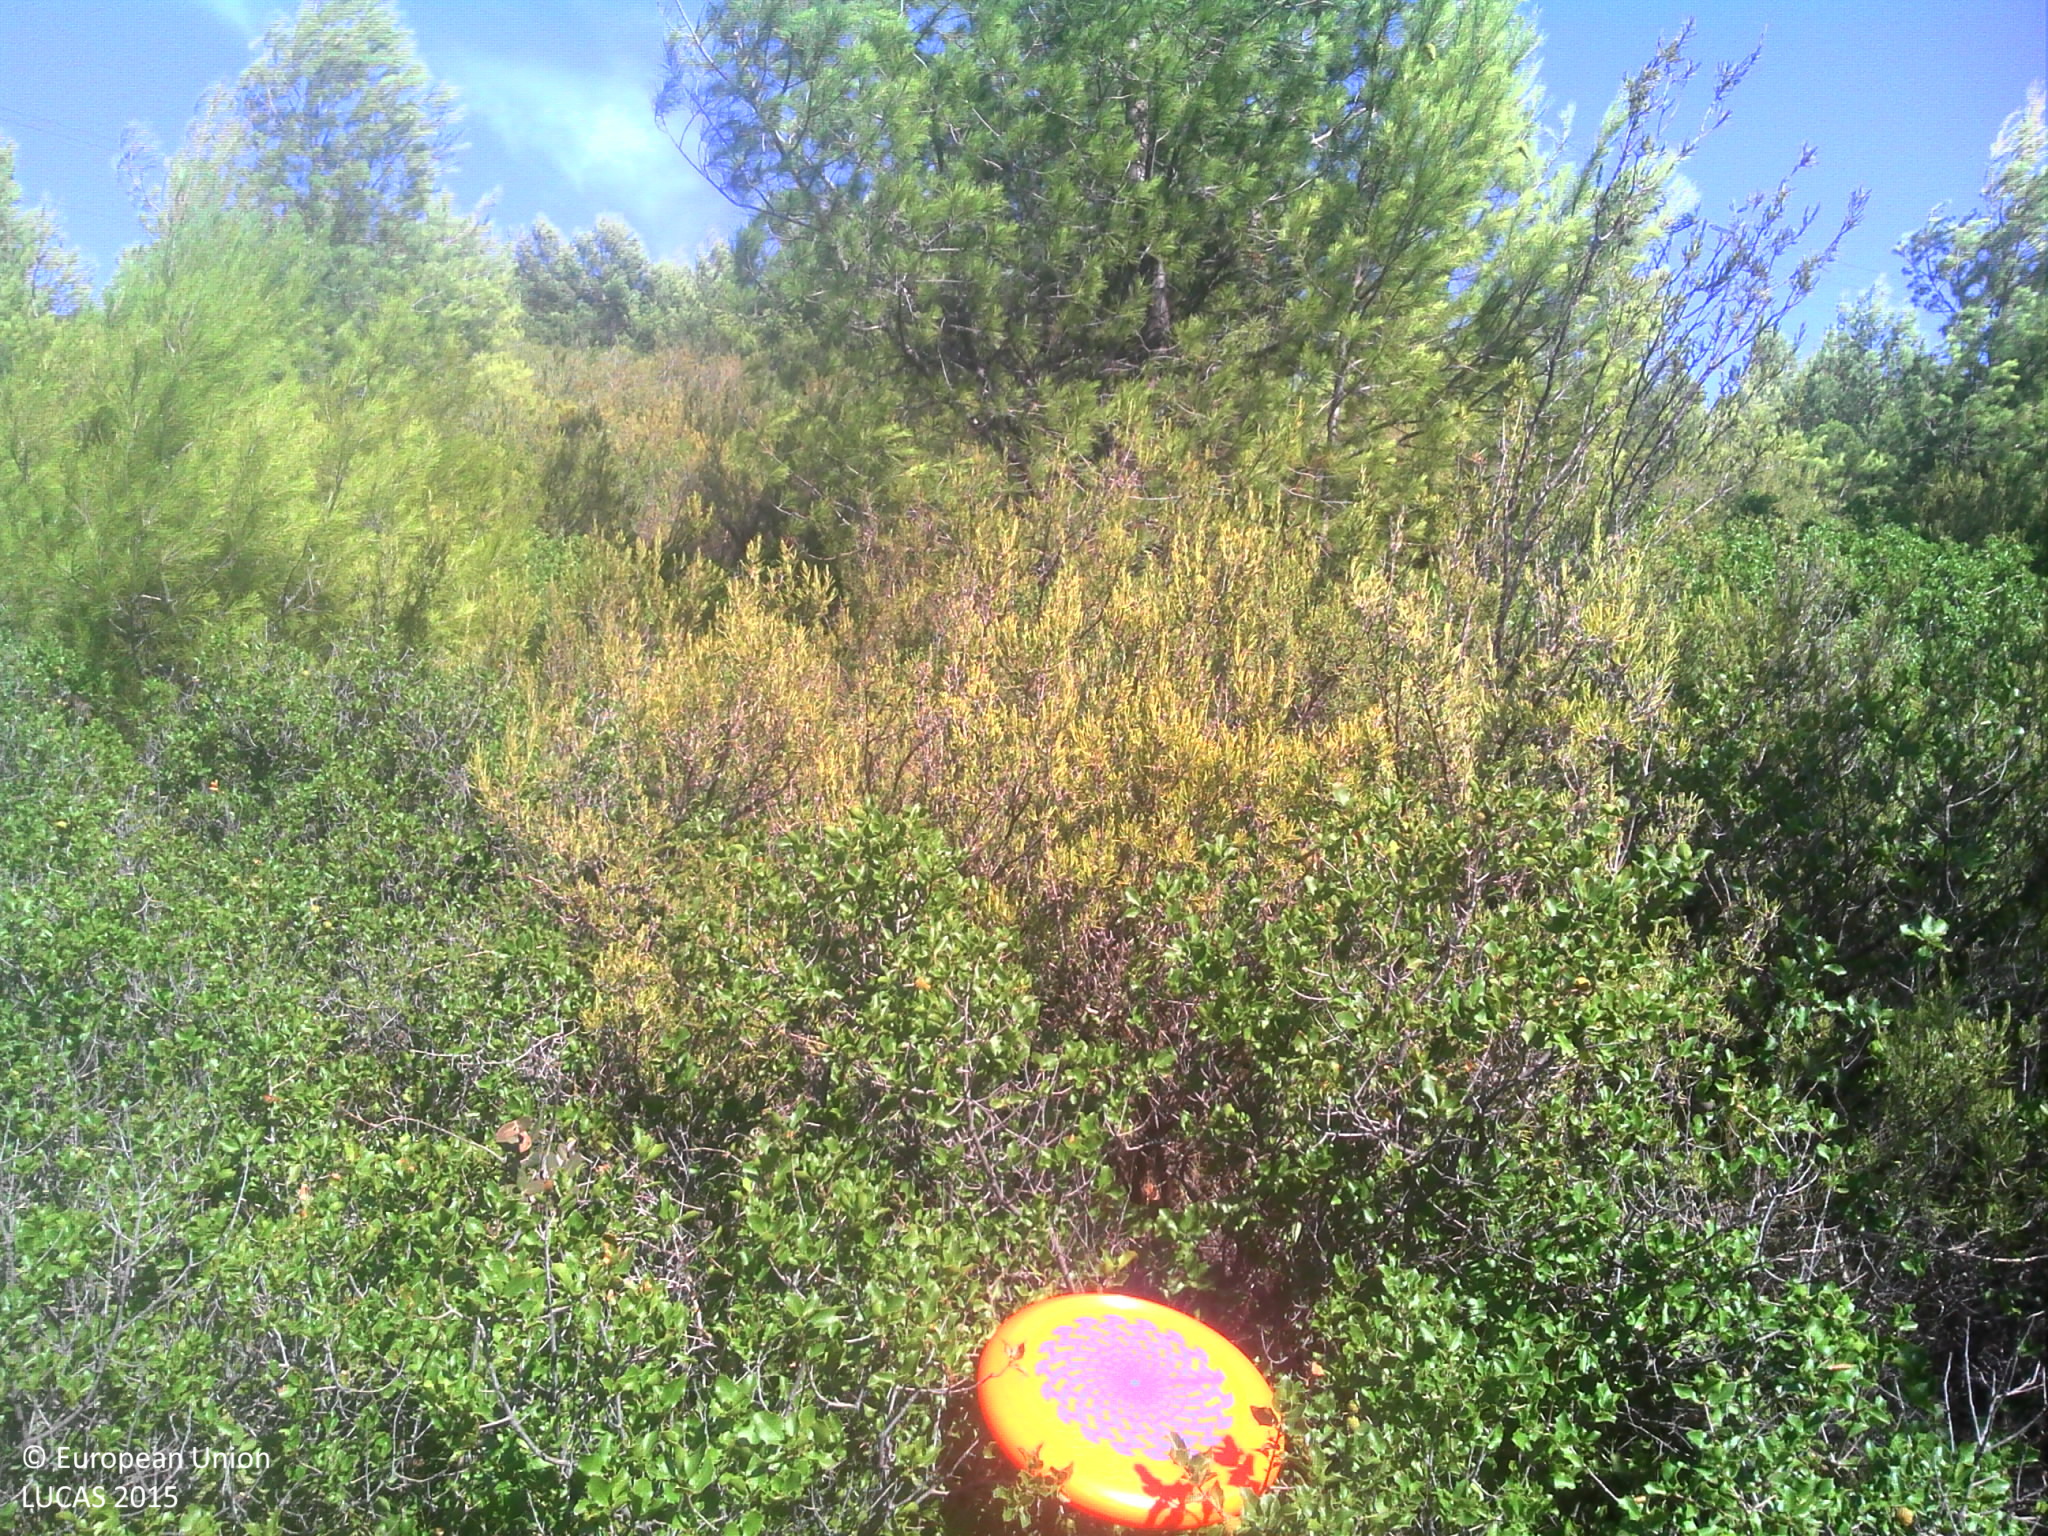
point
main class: Woodland
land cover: Pine dominated coniferous woodland
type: coniferous forest of the mediterranean region
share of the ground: 25 - 50 %
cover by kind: shrubs 55 %, coniferous forest trees 45 %
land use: Forestry
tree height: < 5 m
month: August
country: FR
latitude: 43.3804
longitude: 5.3815
